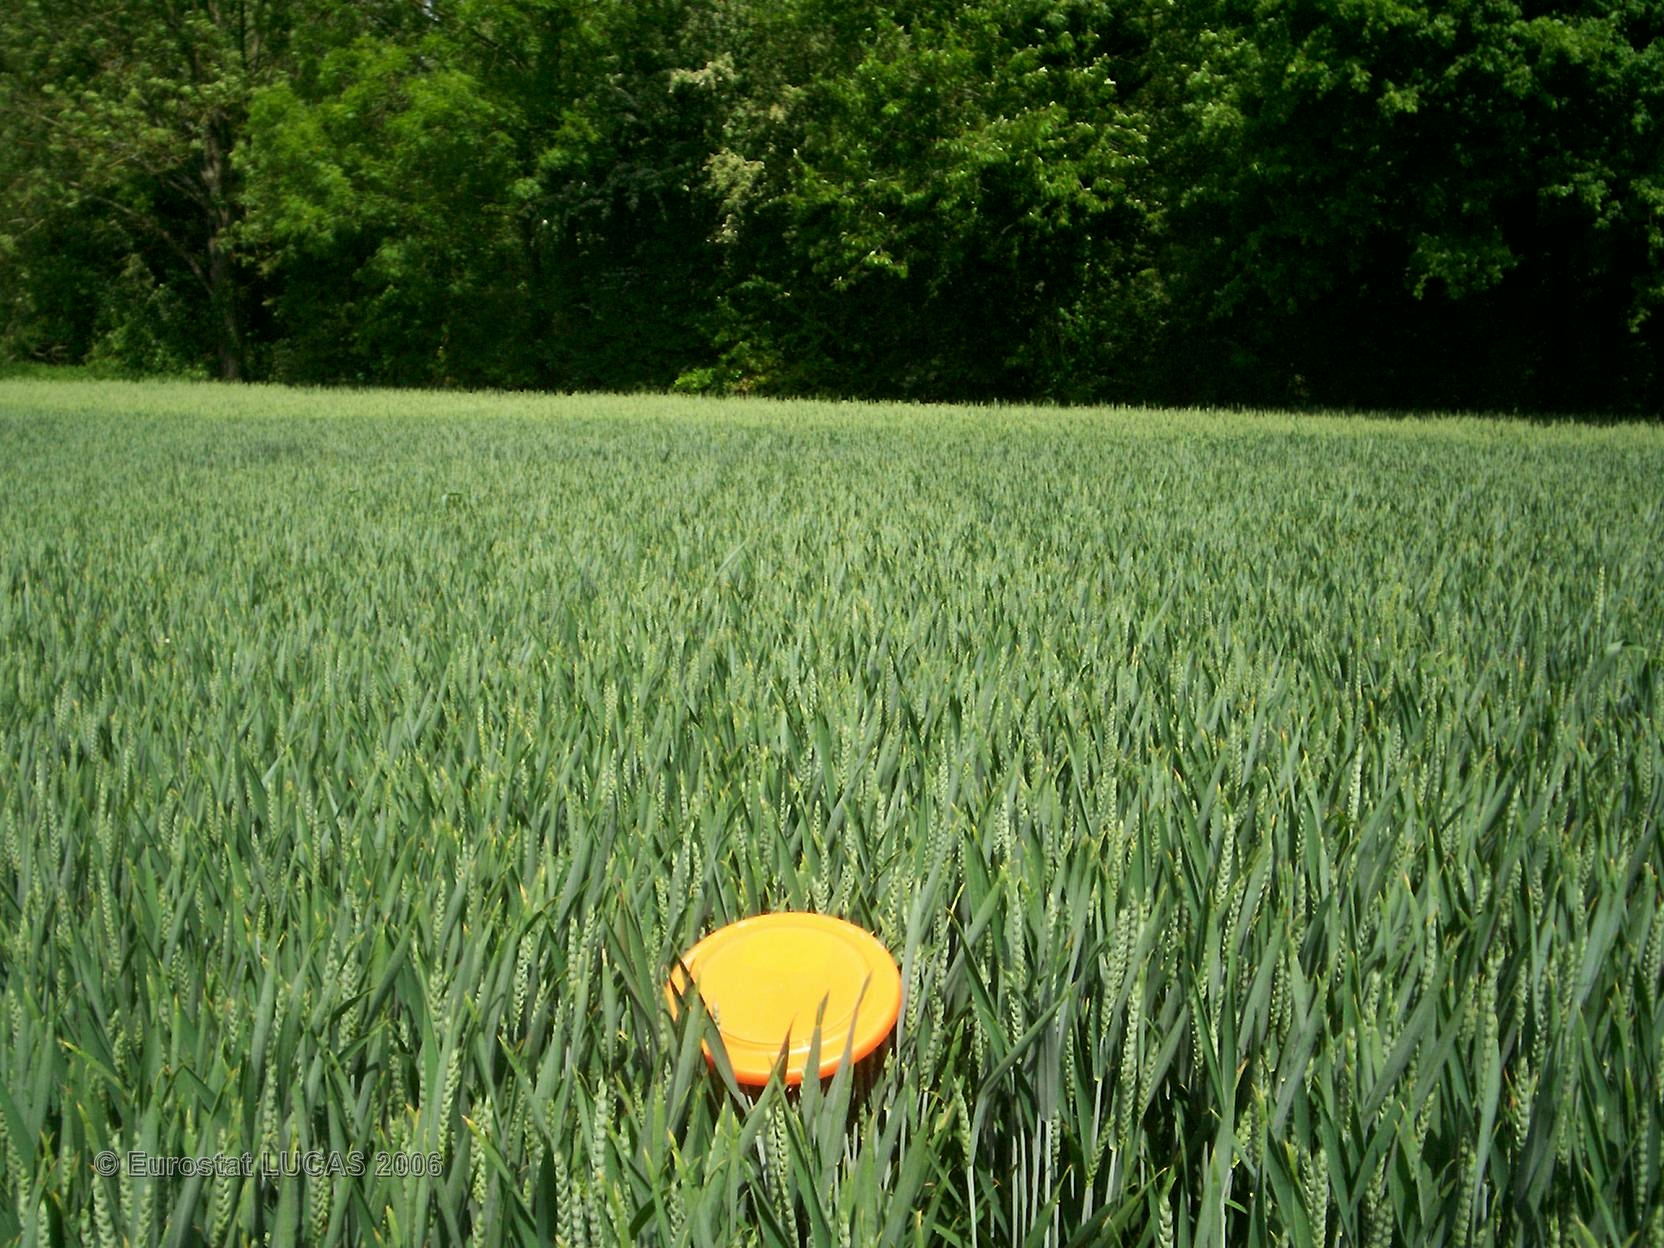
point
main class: Cropland
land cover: Common wheat
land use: Agriculture (excluding fallow land and kitchen gardens)
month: May
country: FR
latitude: 46.5789
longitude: -0.8483
